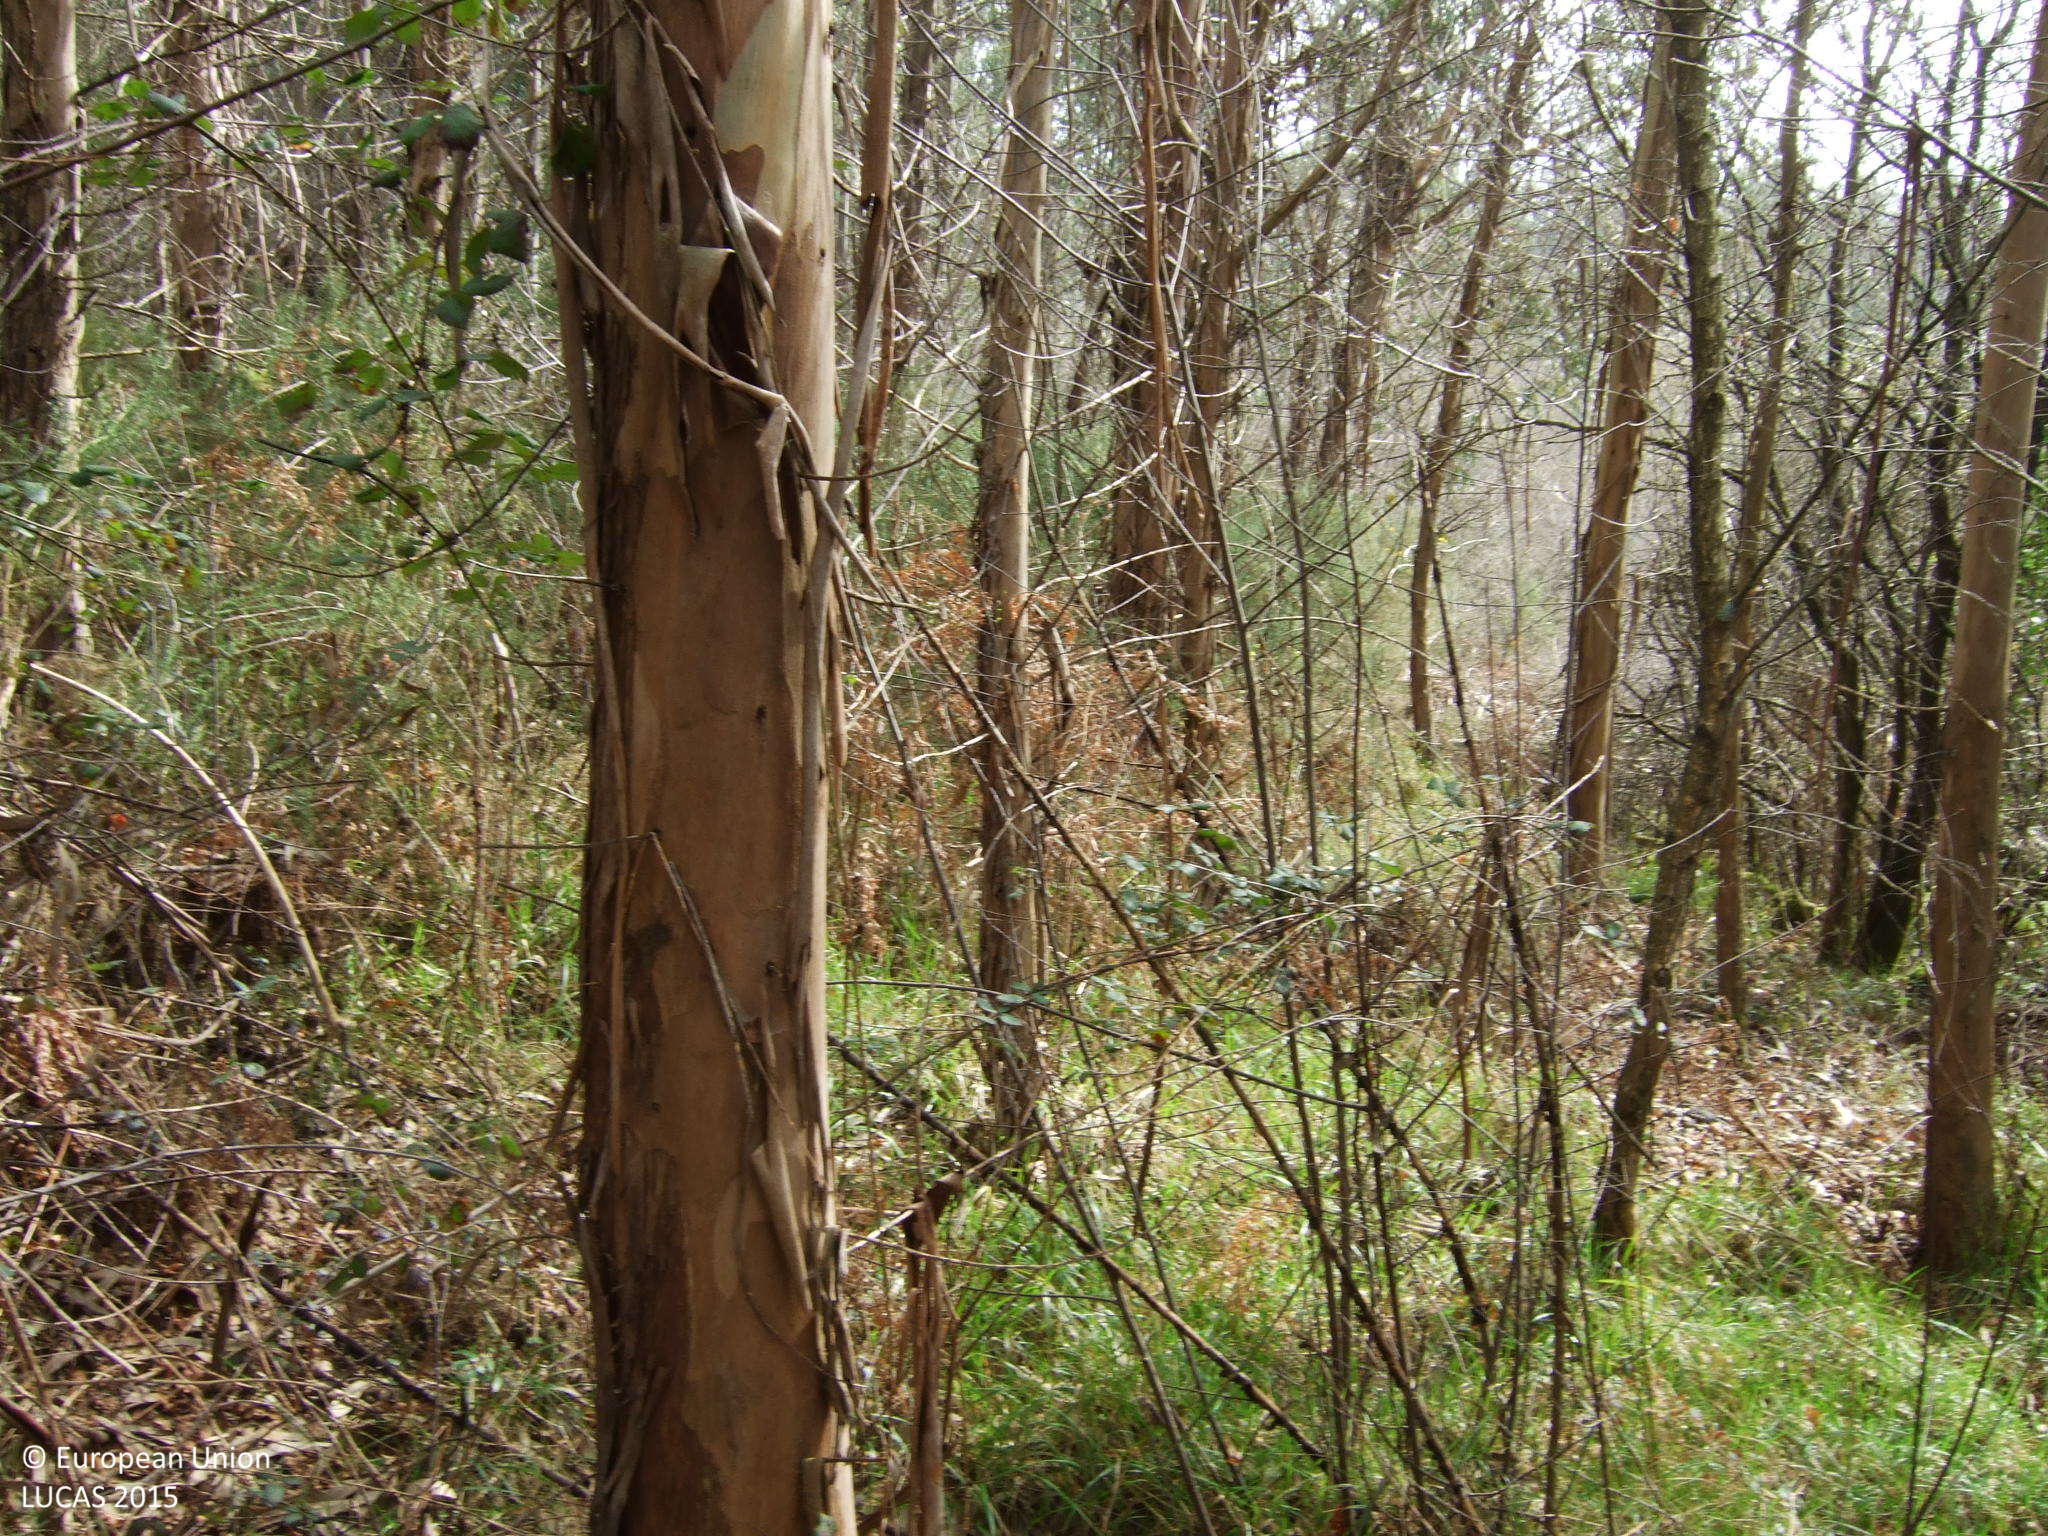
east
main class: Woodland
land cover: Broadleaved woodland
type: exotic forest
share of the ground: > 75 %
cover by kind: broadleaved forest trees 90 %, shrubs 10 %
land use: Forestry
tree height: > 5 m
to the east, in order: Broadleaved woodland; Shruby margins; Dry stone walls; Tracks; Broadleaved woodland; Dry stone walls; Broadleaved woodland; Shruby margins; Groves; Pine dominated coniferous woodland
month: March
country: ES
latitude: 42.9238
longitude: -7.9123
